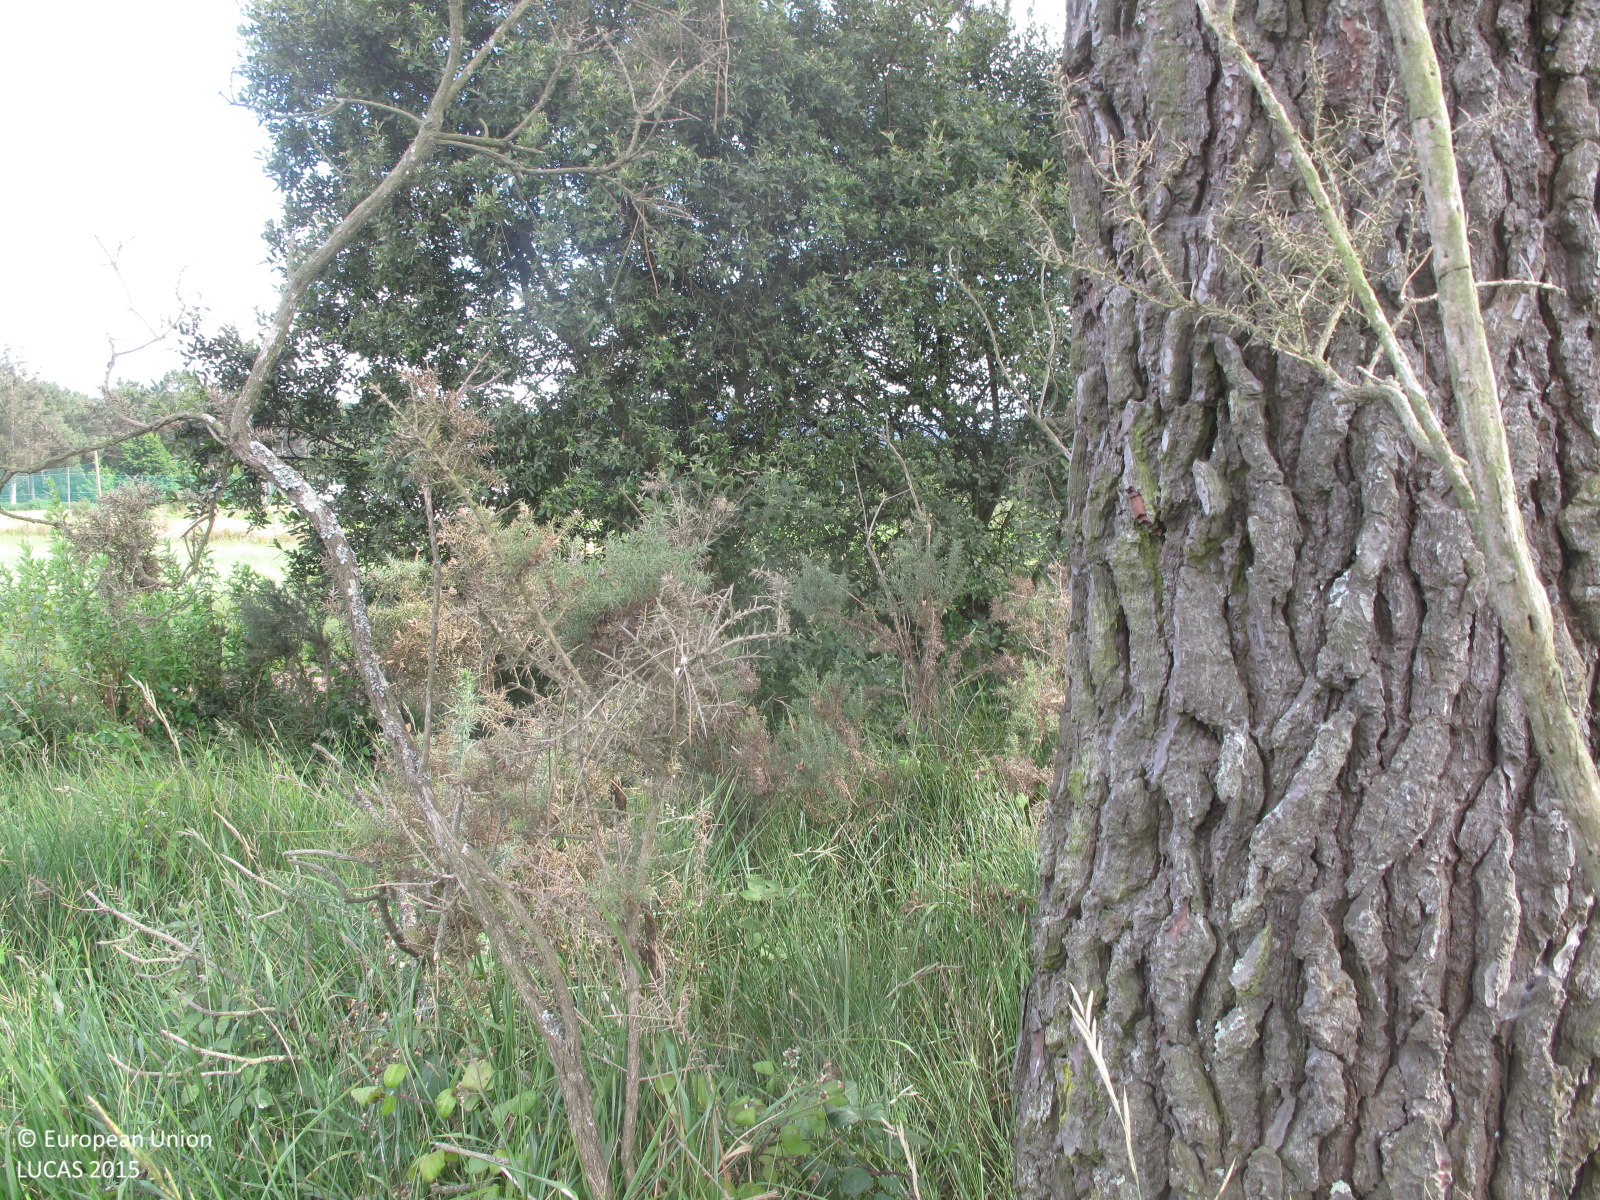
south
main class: Woodland
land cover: Pine dominated mixed woodland
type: exotic forest
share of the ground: 50 - 75 %
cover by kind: coniferous forest trees 40 %, broadleaved forest trees 20 %, shrubs 20 %, herbaceous plants 20 %
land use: Forestry
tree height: > 5 m
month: July
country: ES
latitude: 43.2642
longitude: -8.5781
